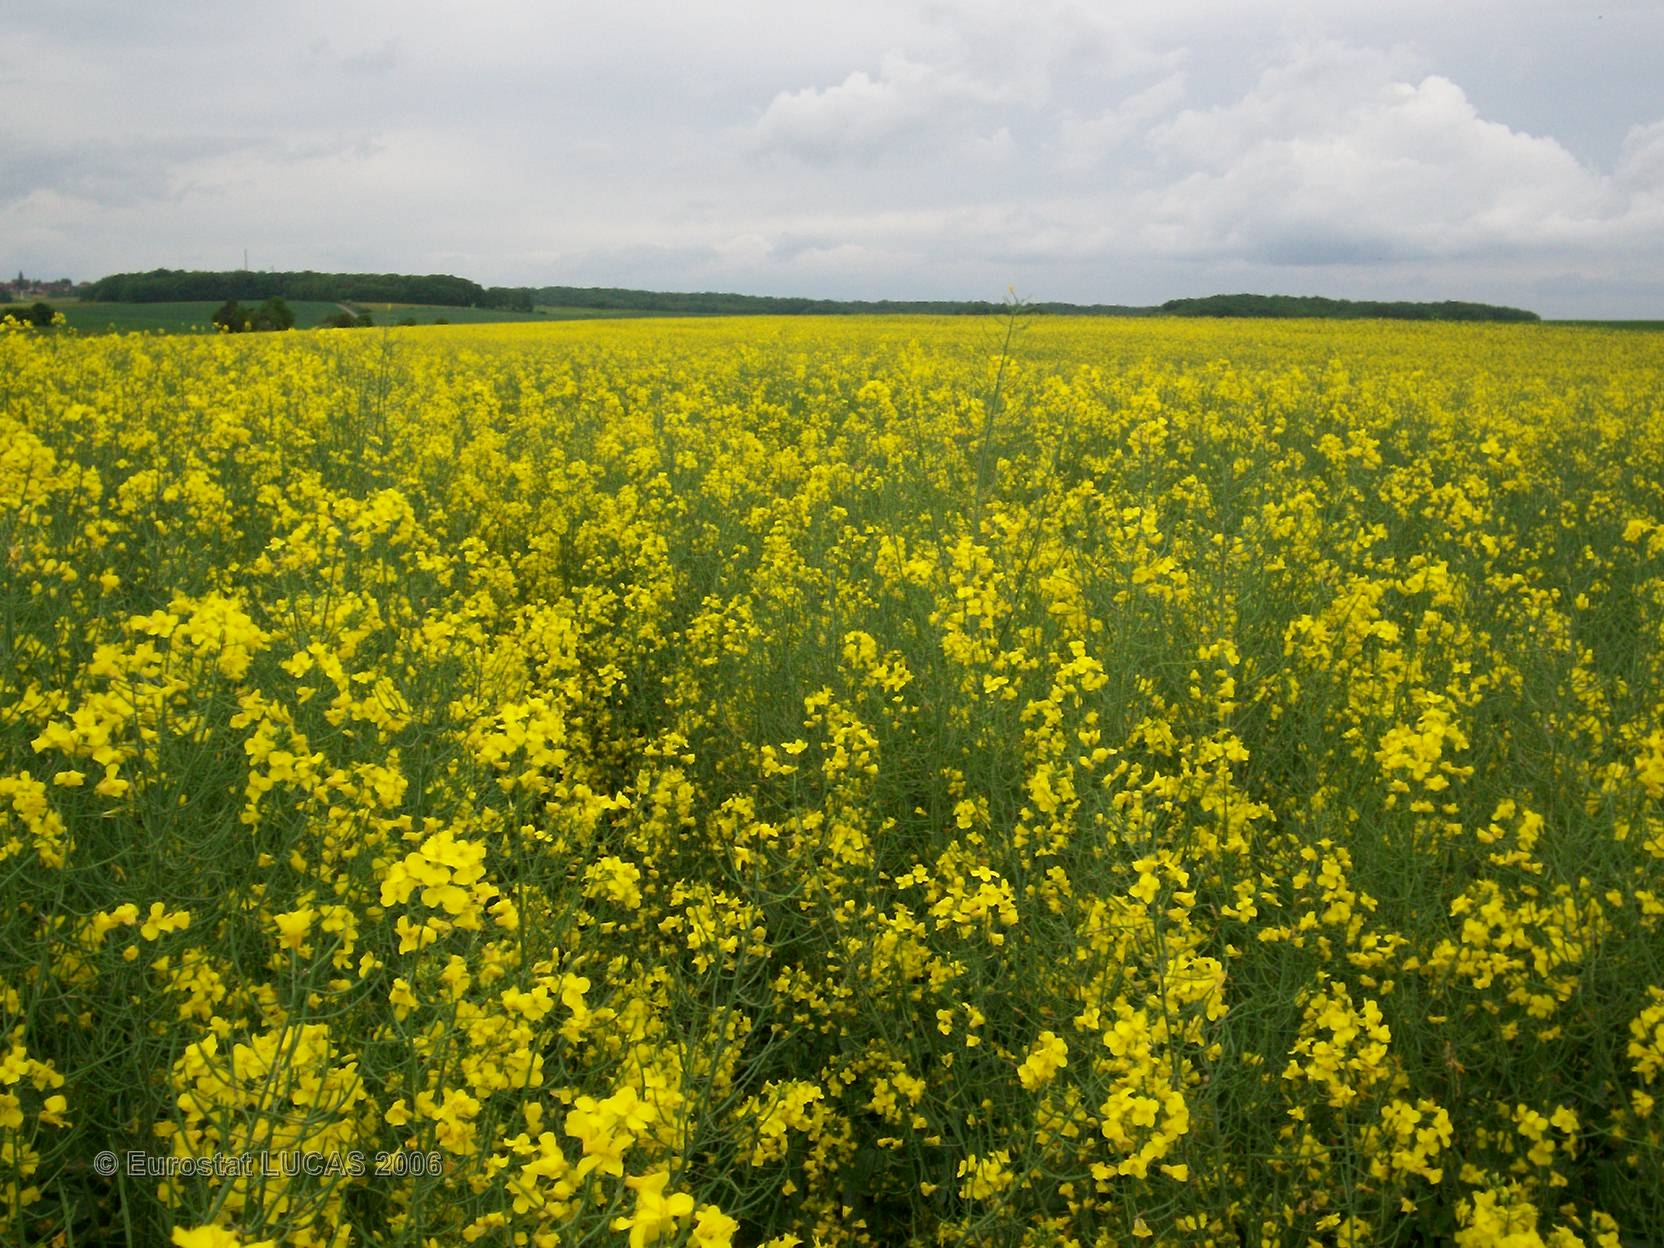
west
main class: Cropland
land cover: Rape and turnip rape
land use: Agriculture (excluding fallow land and kitchen gardens)
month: May
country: FR
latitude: 48.1943
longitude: 4.4954
